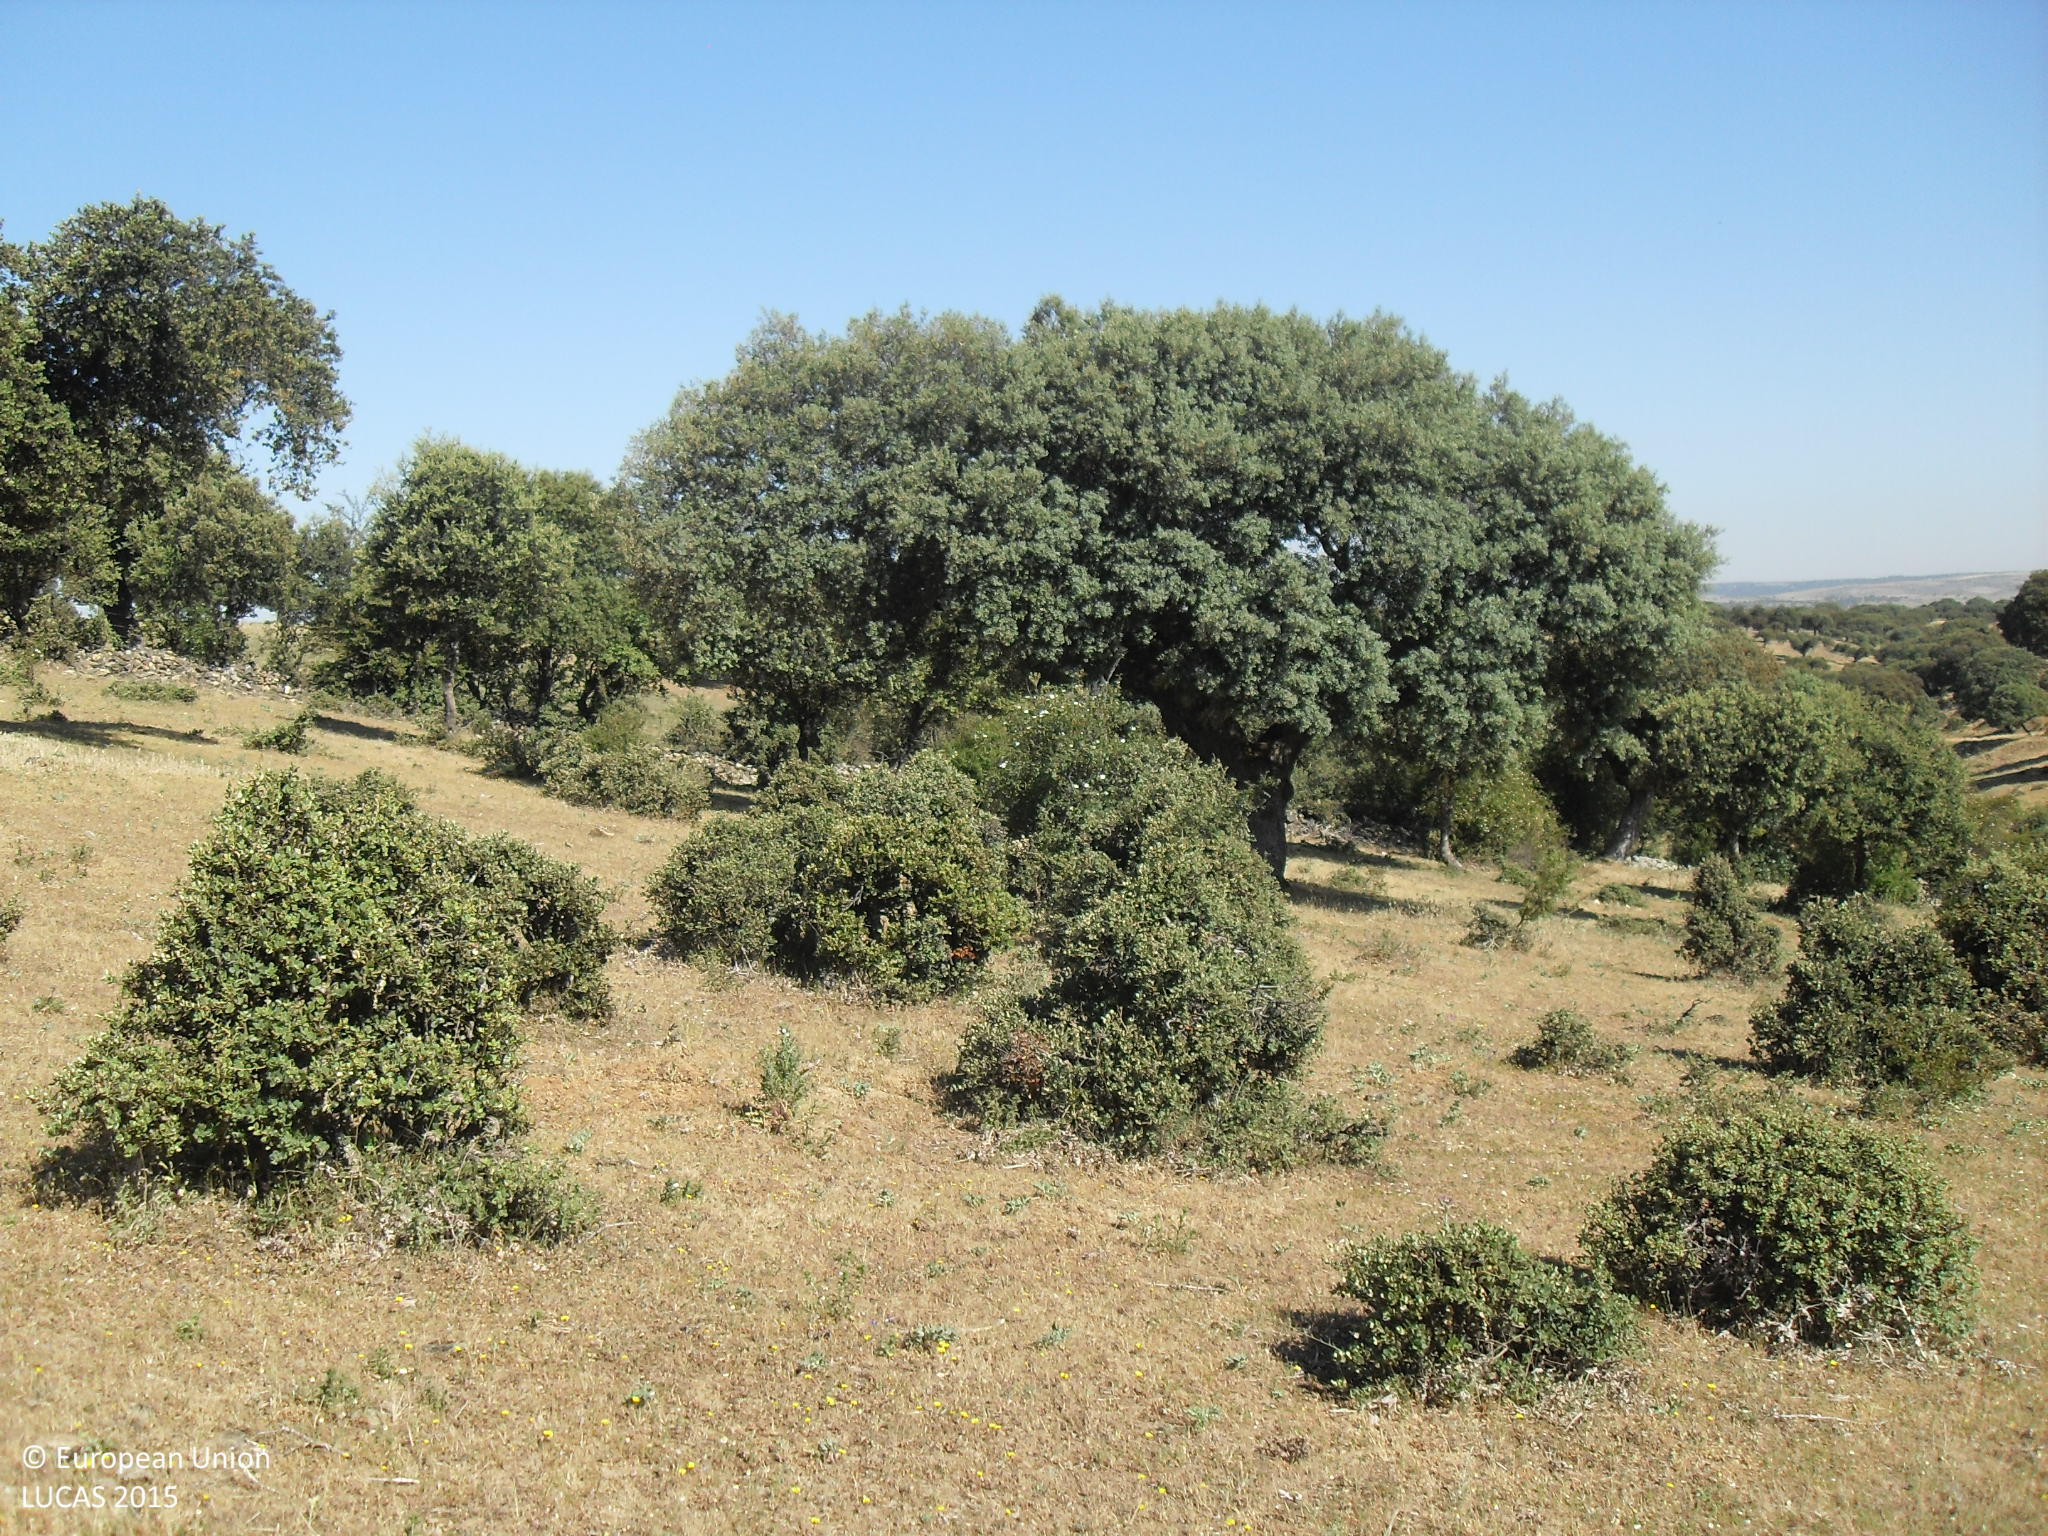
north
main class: Woodland
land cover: Broadleaved woodland
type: broadleaved evergreen forest
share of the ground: 10 - 25 %
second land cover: Grassland without tree/shrub cover
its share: > 75 %
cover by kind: herbaceous plants 80 %, broadleaved forest trees 15 %, shrubs 5 %
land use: Forestry
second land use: Agriculture (excluding fallow land and kitchen gardens)
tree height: > 5 m
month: June
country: ES
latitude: 40.6685
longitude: -5.5797
